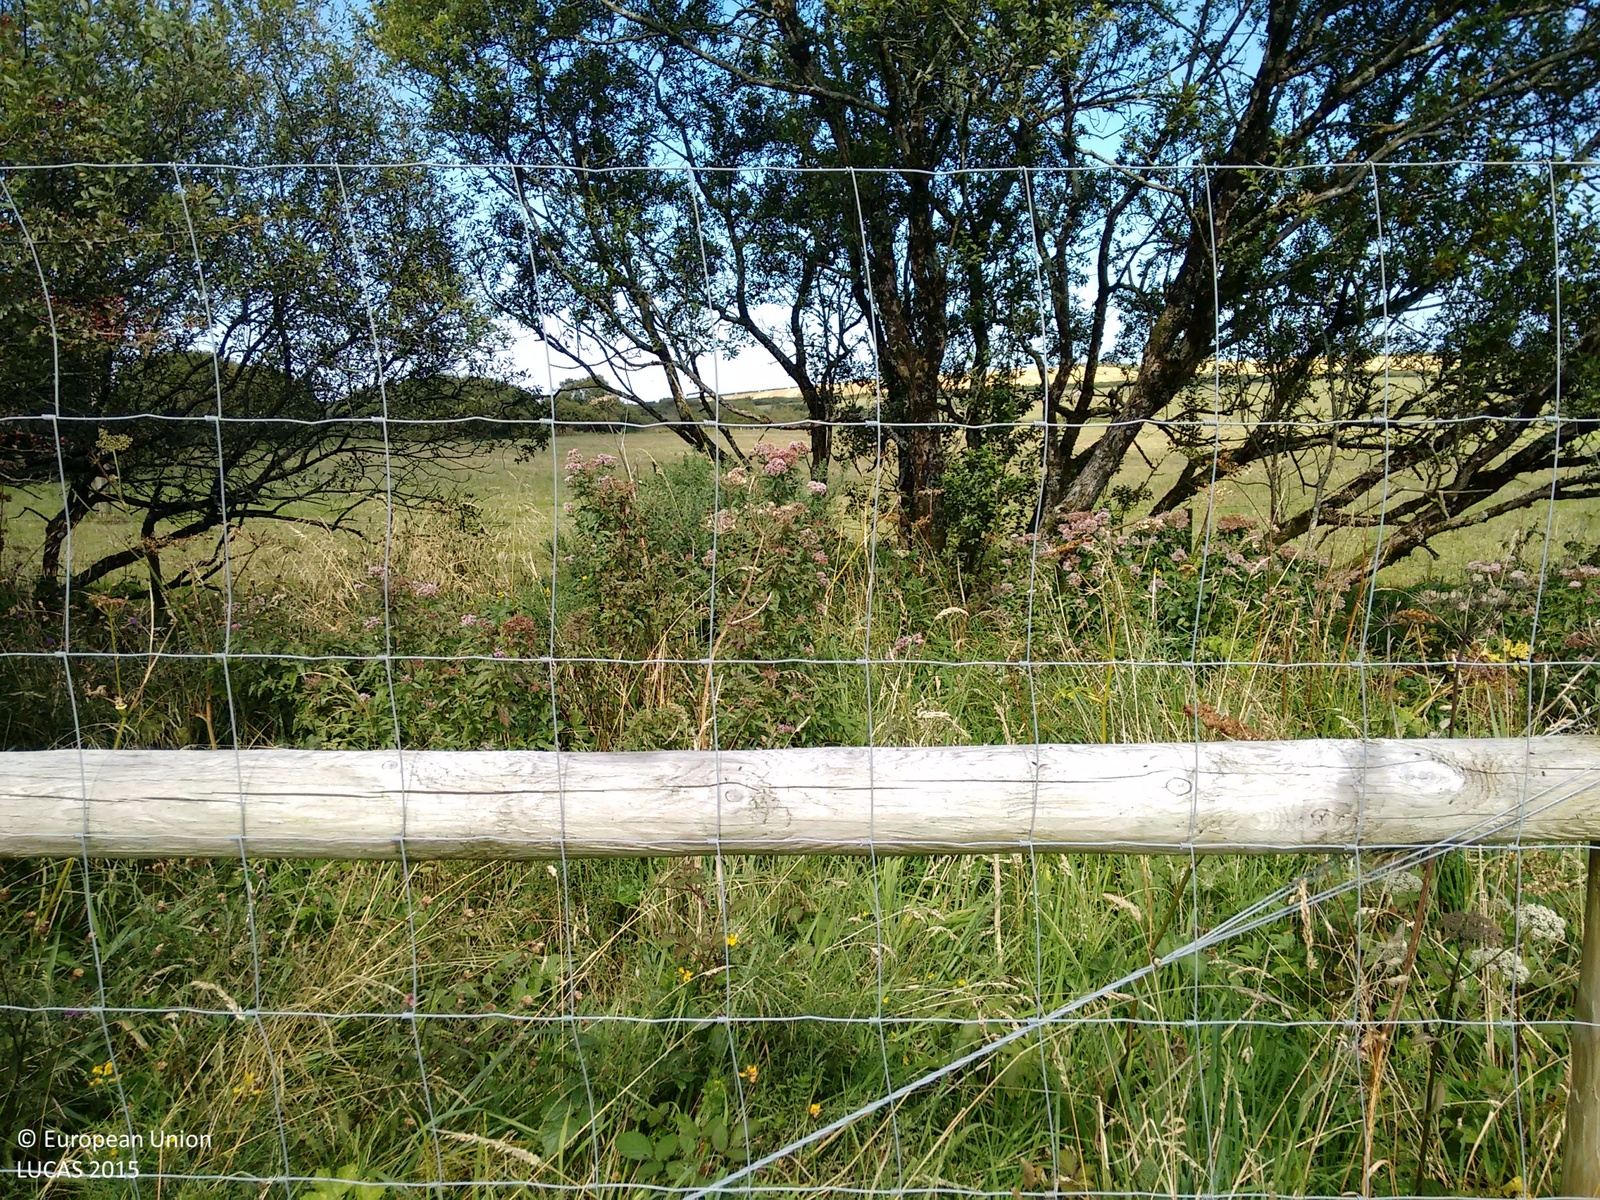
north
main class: Woodland
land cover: Broadleaved woodland
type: mesophytic deciduous forest
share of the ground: > 75 %
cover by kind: broadleaved forest trees 100 %
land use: Semi-natural and natural areas not in use
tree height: > 5 m
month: September
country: GB
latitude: 50.9582
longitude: -4.4402
